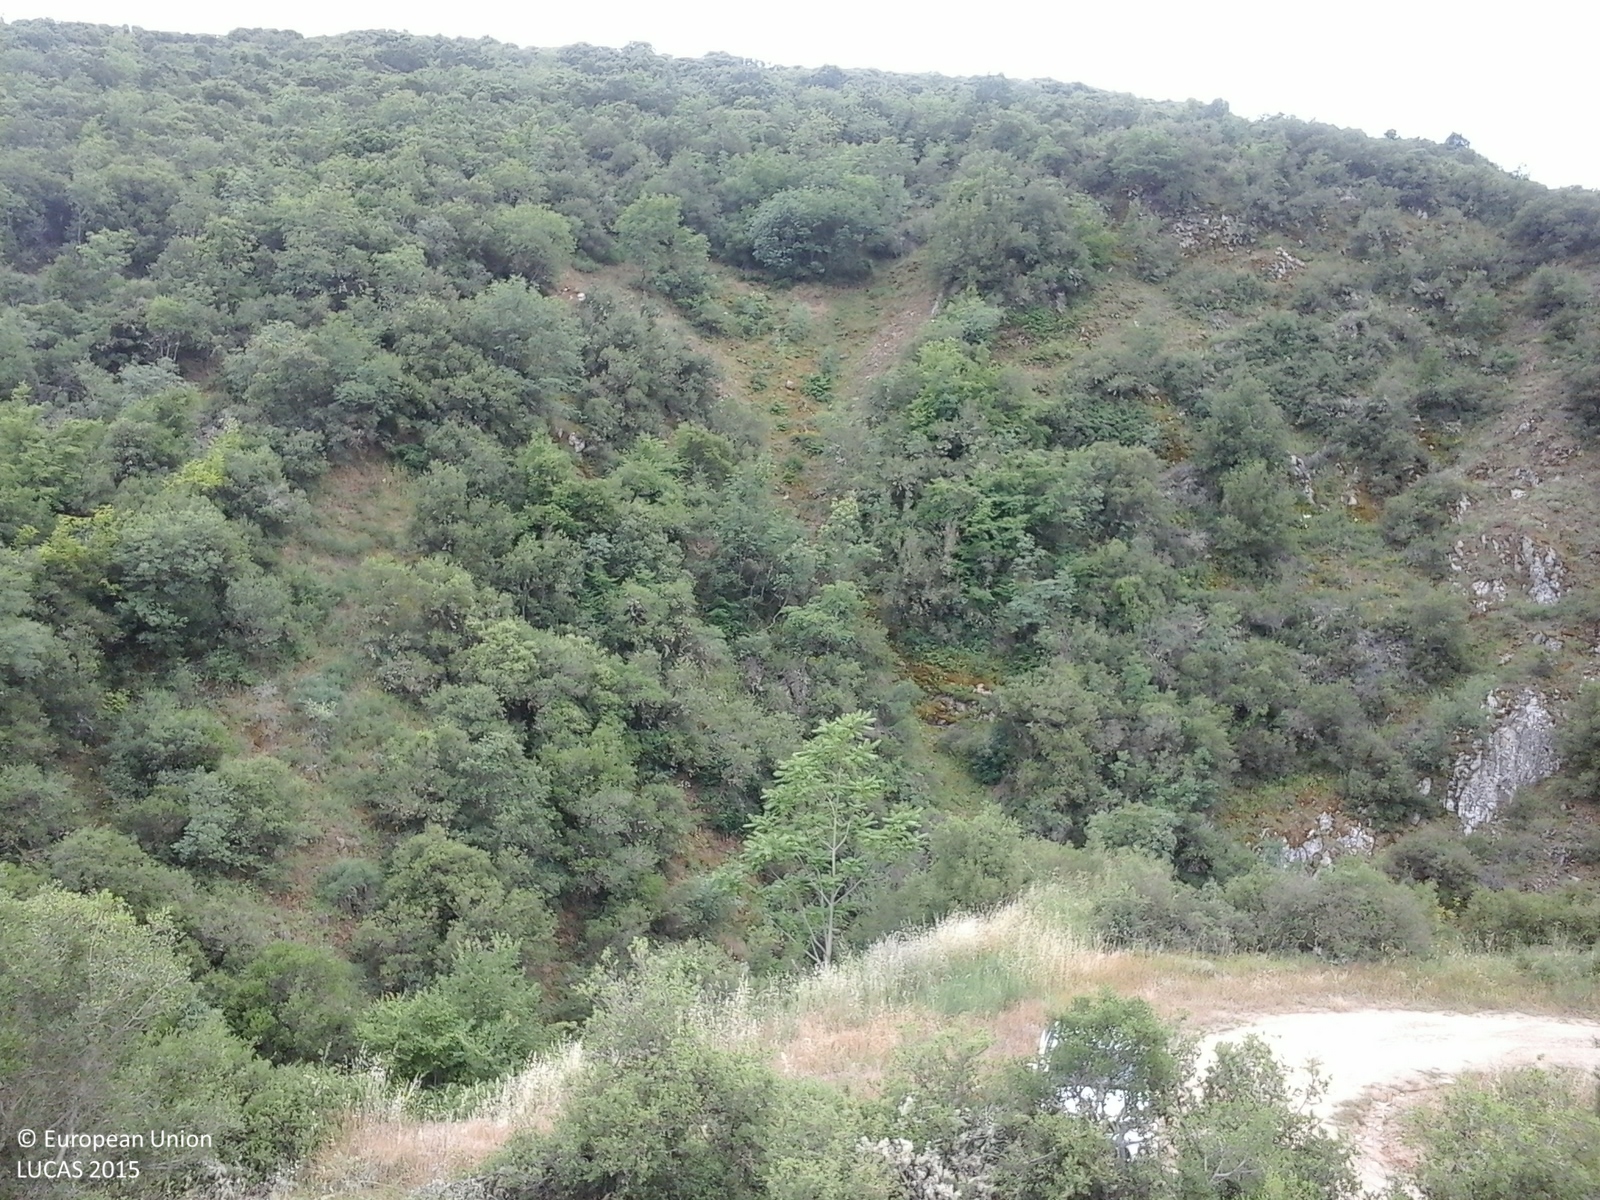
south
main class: Shrubland
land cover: Shrubland without tree cover
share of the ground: > 75 %
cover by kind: shrubs 90 %, herbaceous plants 10 %
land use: Semi-natural and natural areas not in use
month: June
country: GR
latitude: 40.7238
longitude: 23.2121
